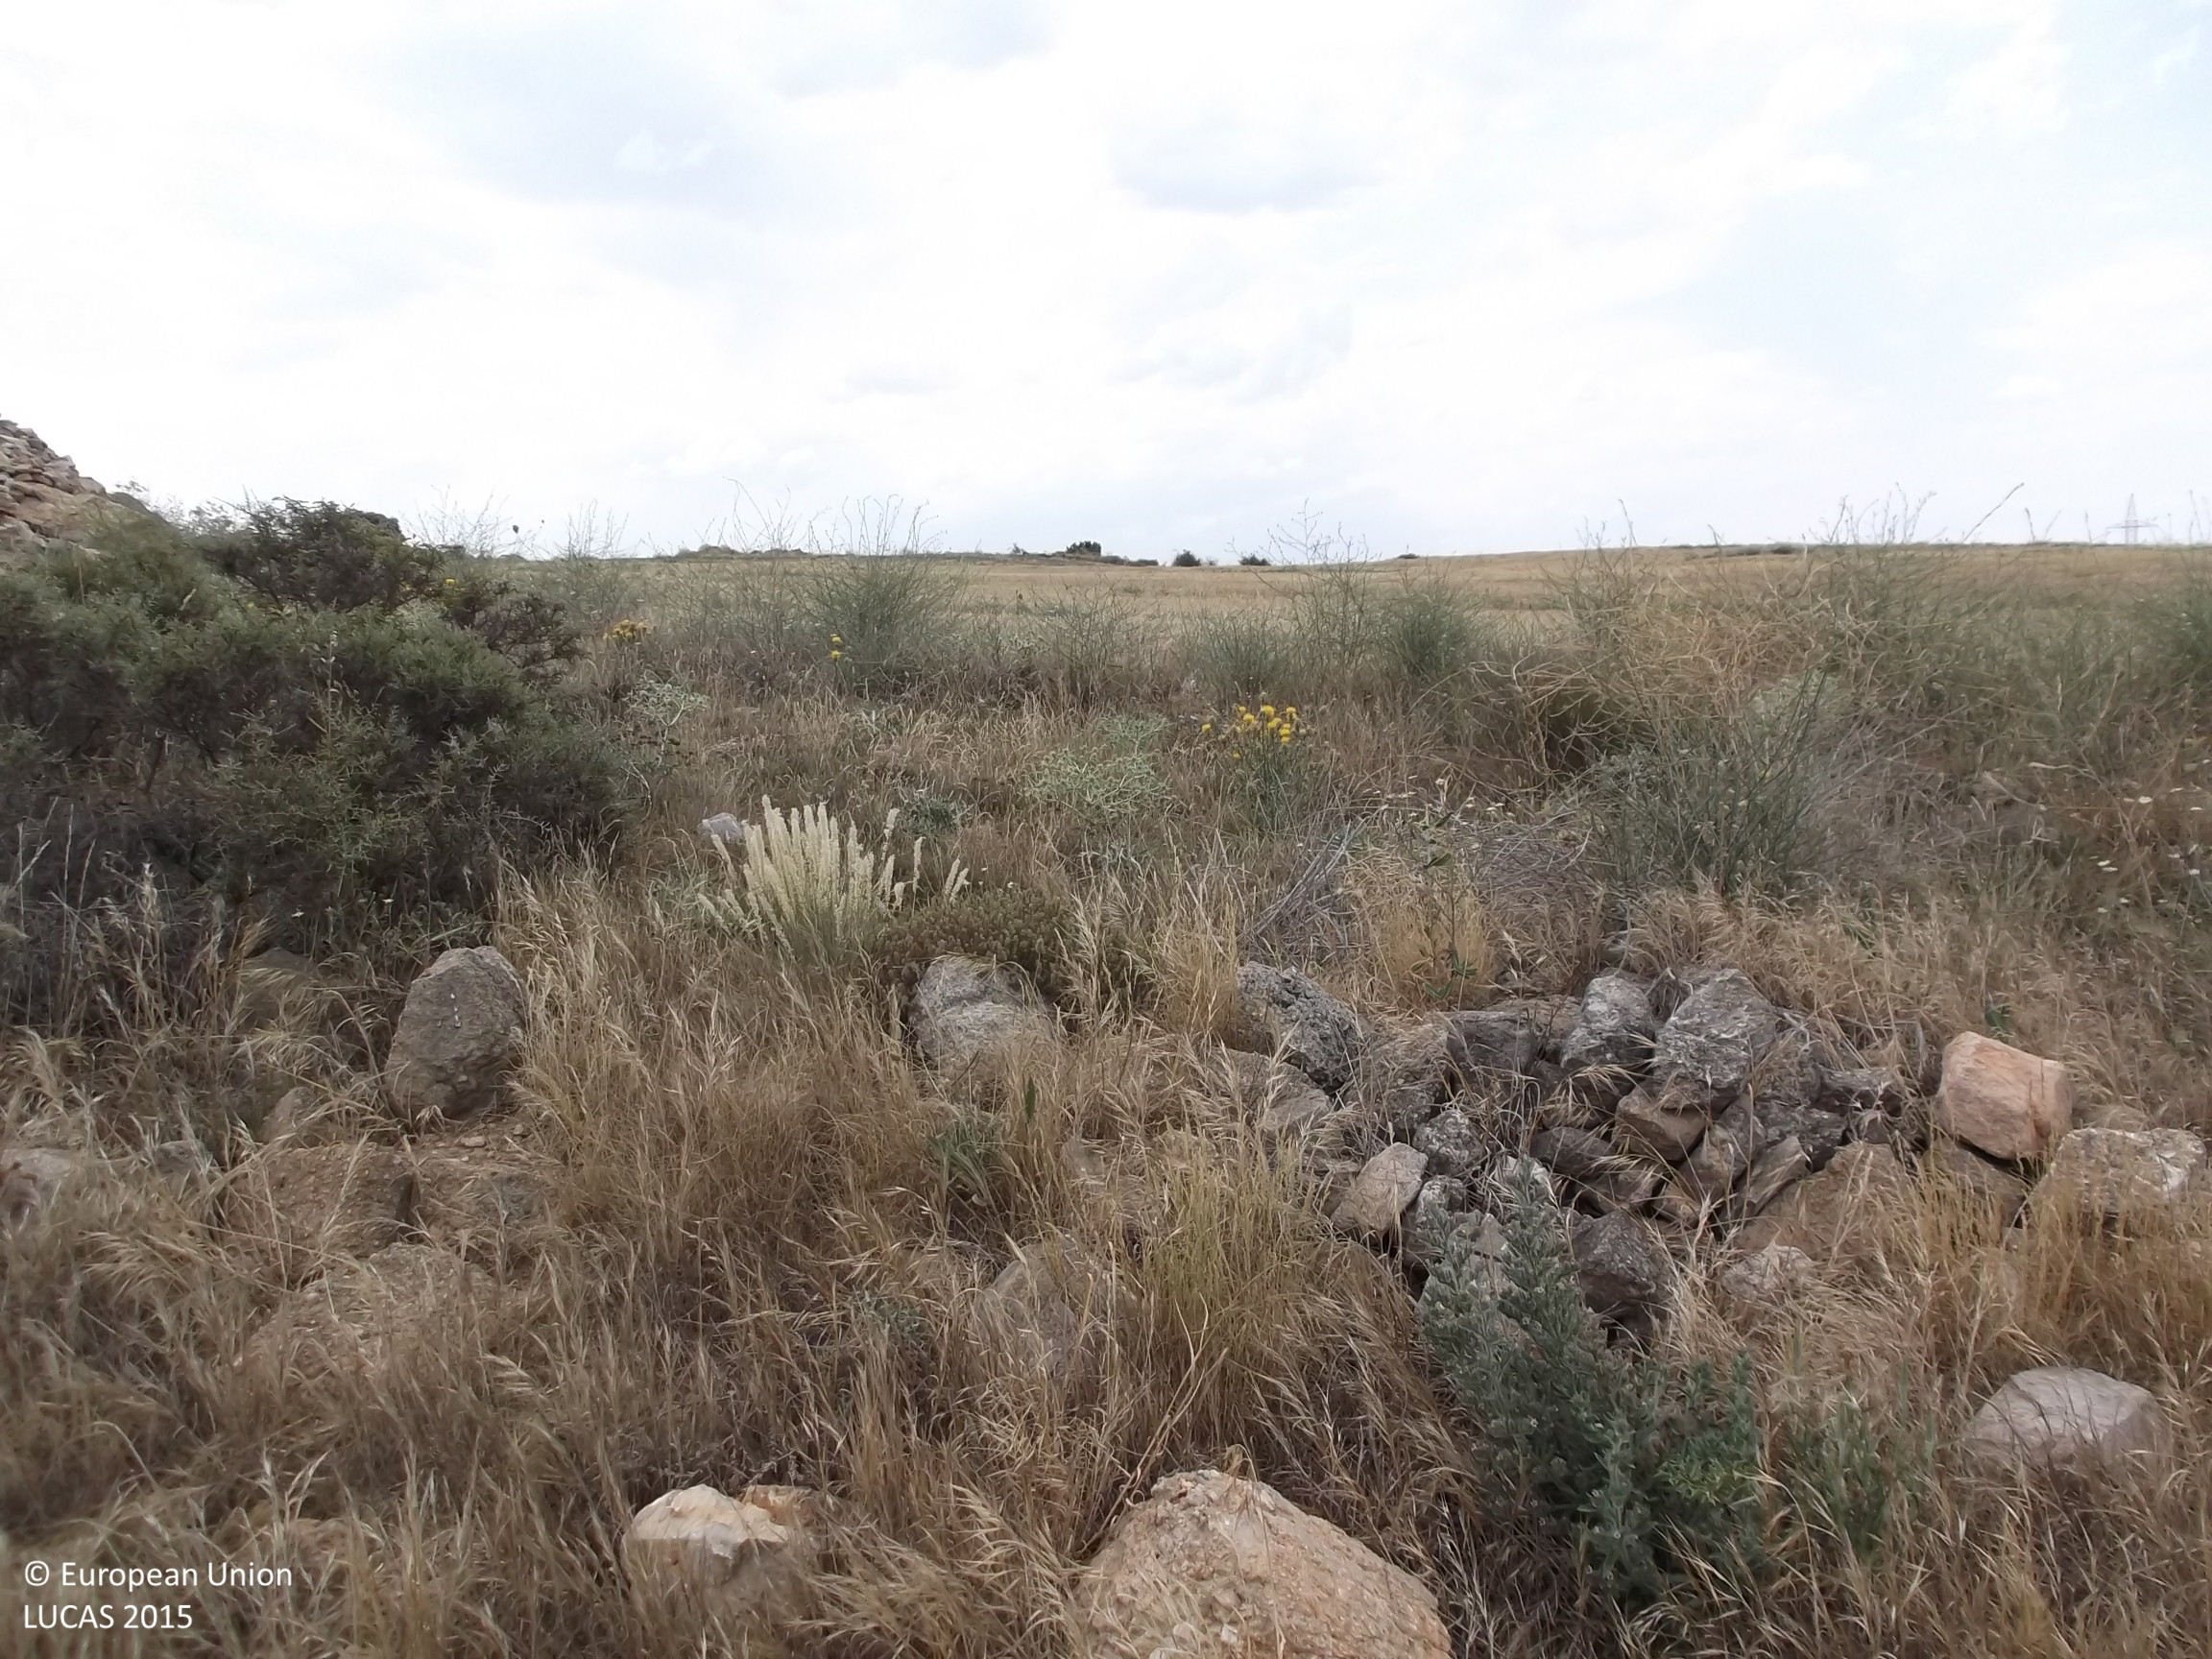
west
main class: Cropland
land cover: Common wheat
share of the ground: < 10 %
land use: Agriculture (excluding fallow land and kitchen gardens)
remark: Harvested field
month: July
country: ES
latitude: 41.8474
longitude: -1.9934
